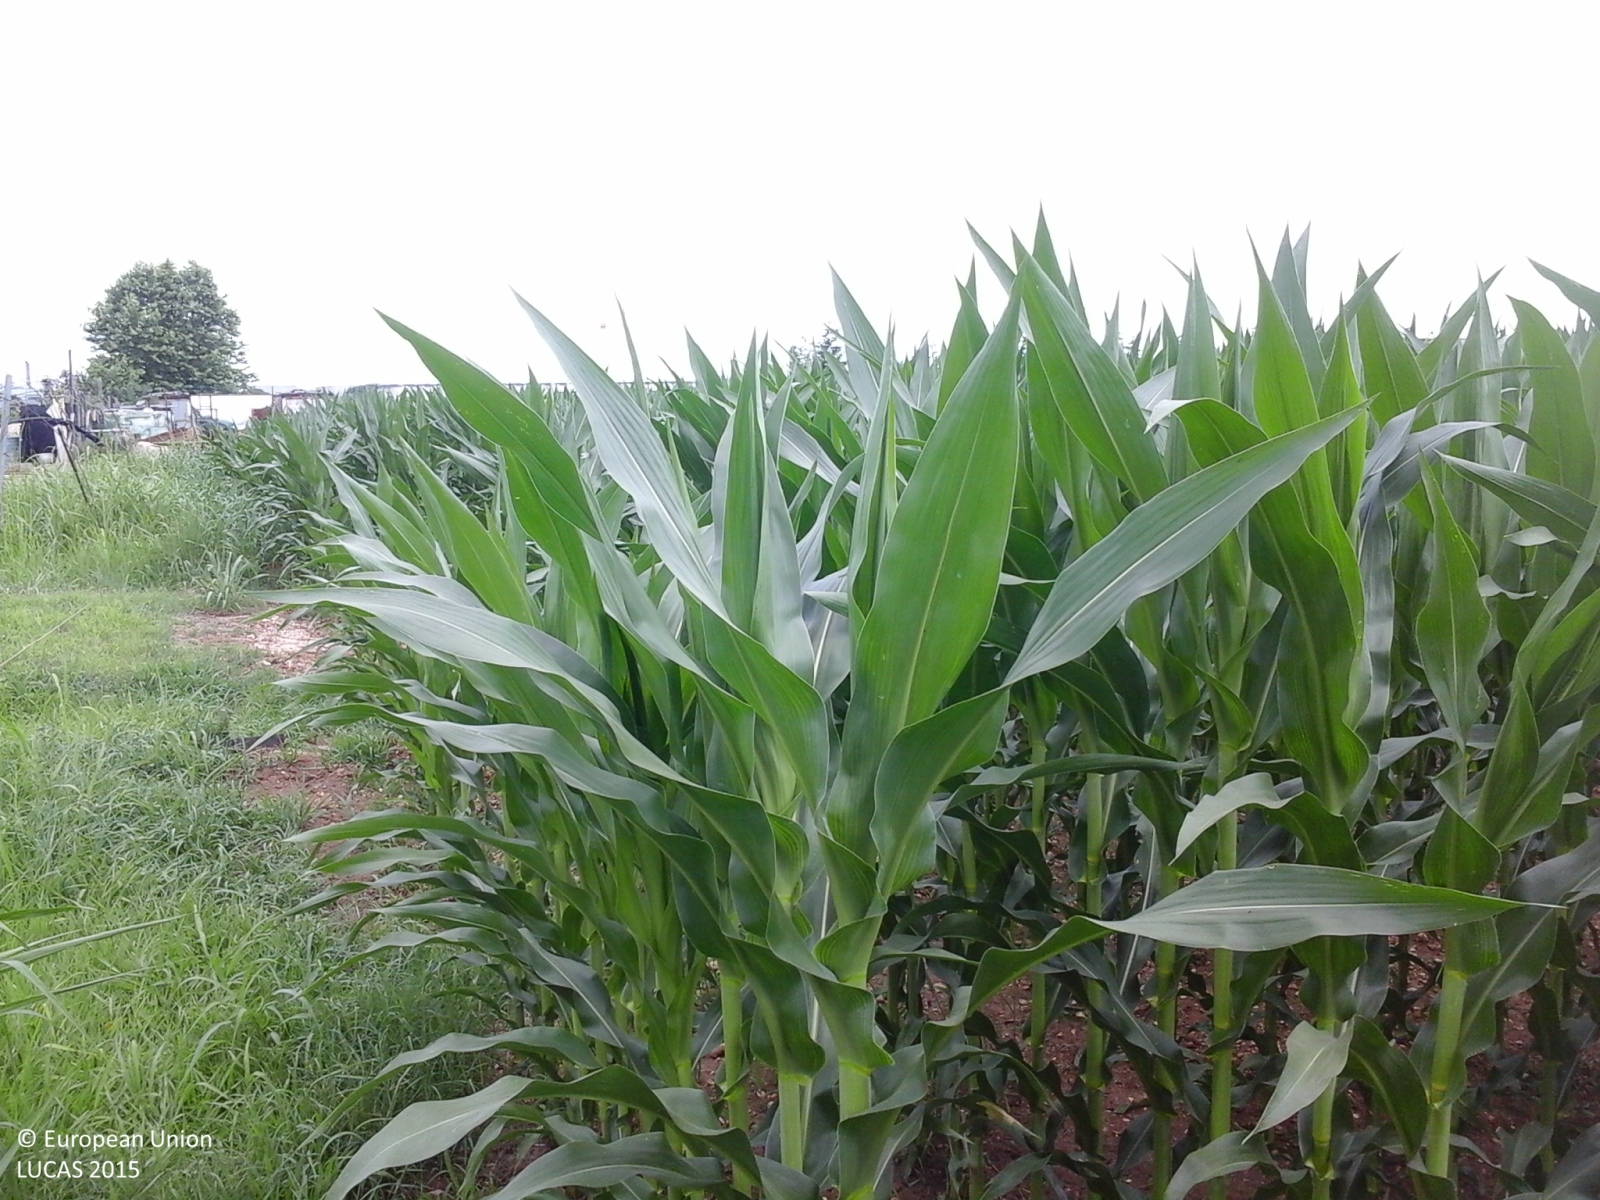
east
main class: Cropland
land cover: Maize
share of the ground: > 75 %
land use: Agriculture (excluding fallow land and kitchen gardens)
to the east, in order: Maize; Grass margins; Fences; Conifer hedges; Olive groves; Artificial constructions in urban areas; Conifer hedges; Fences; Maize; Grassland without tree/shrub cover; Maize; Fences; Other fruit trees and berries
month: June
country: IT
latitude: 45.4106
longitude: 10.8801
